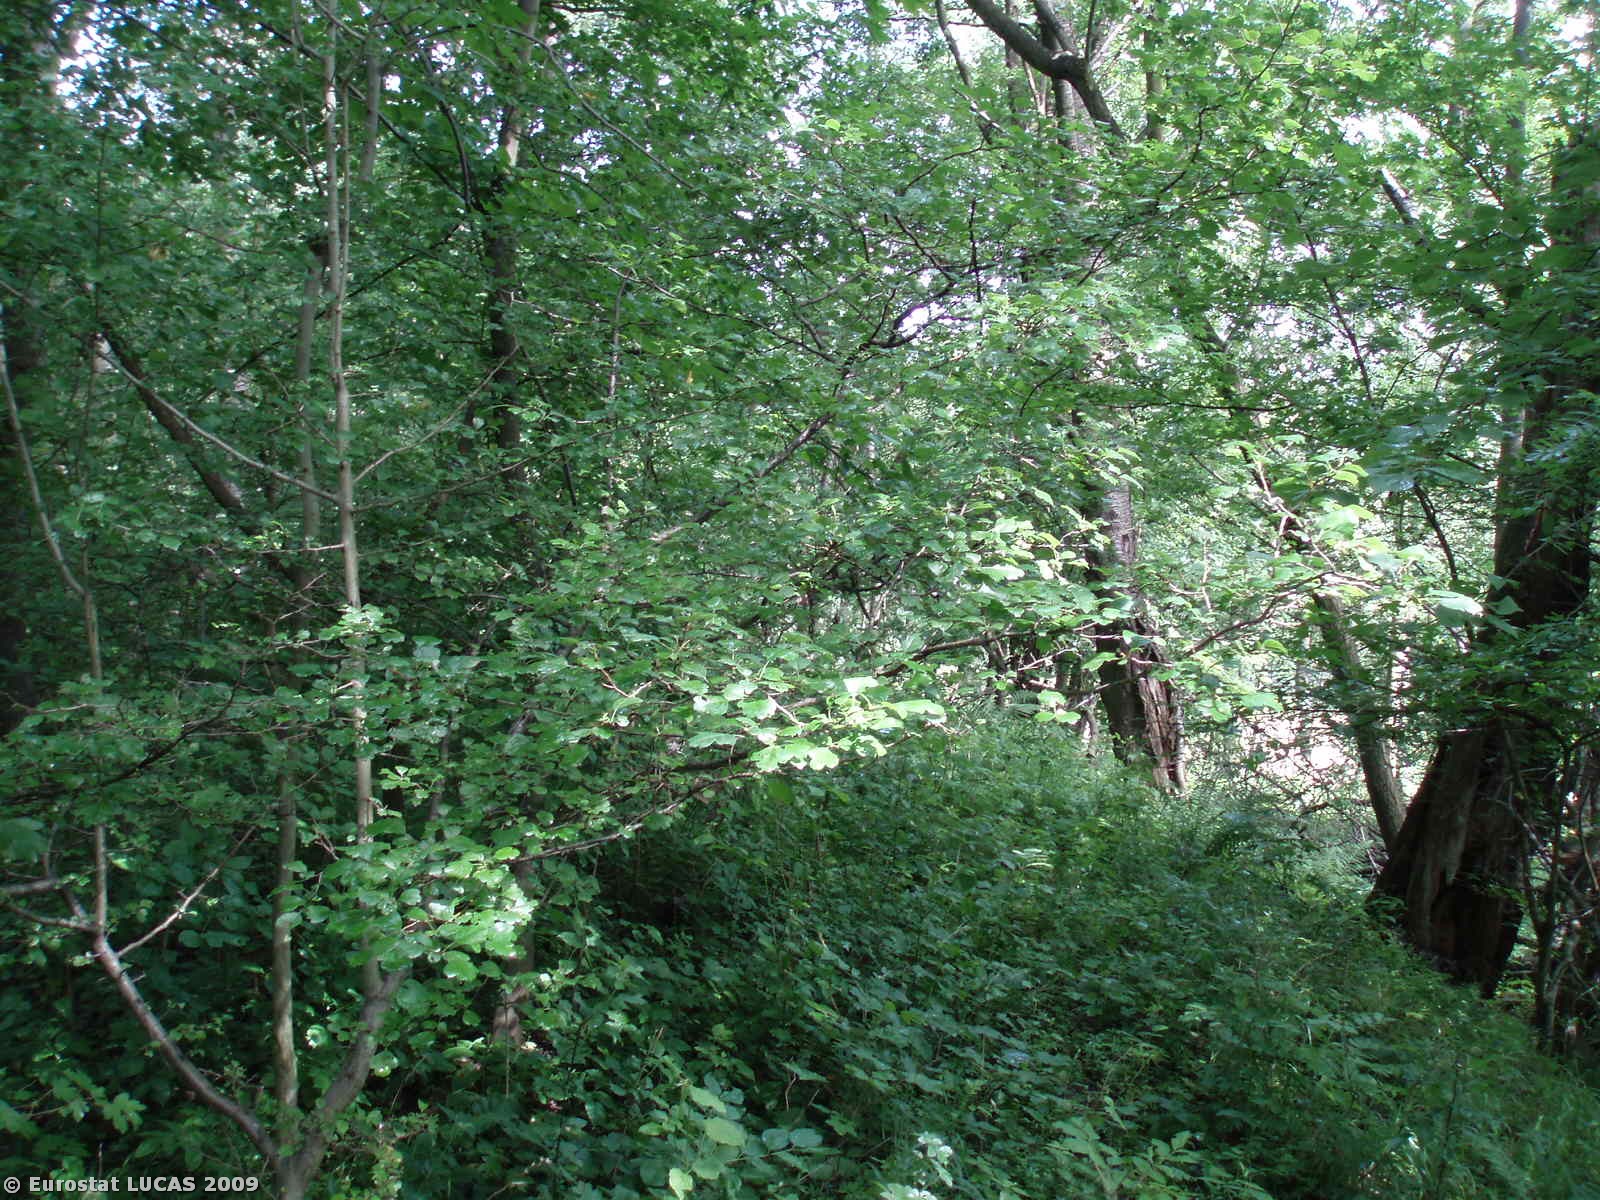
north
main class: Woodland
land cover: Broadleaved woodland
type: mesophytic deciduous forest
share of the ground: > 75 %
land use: Forestry
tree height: > 5 m
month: July
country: CZ
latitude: 50.6850
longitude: 14.1483
